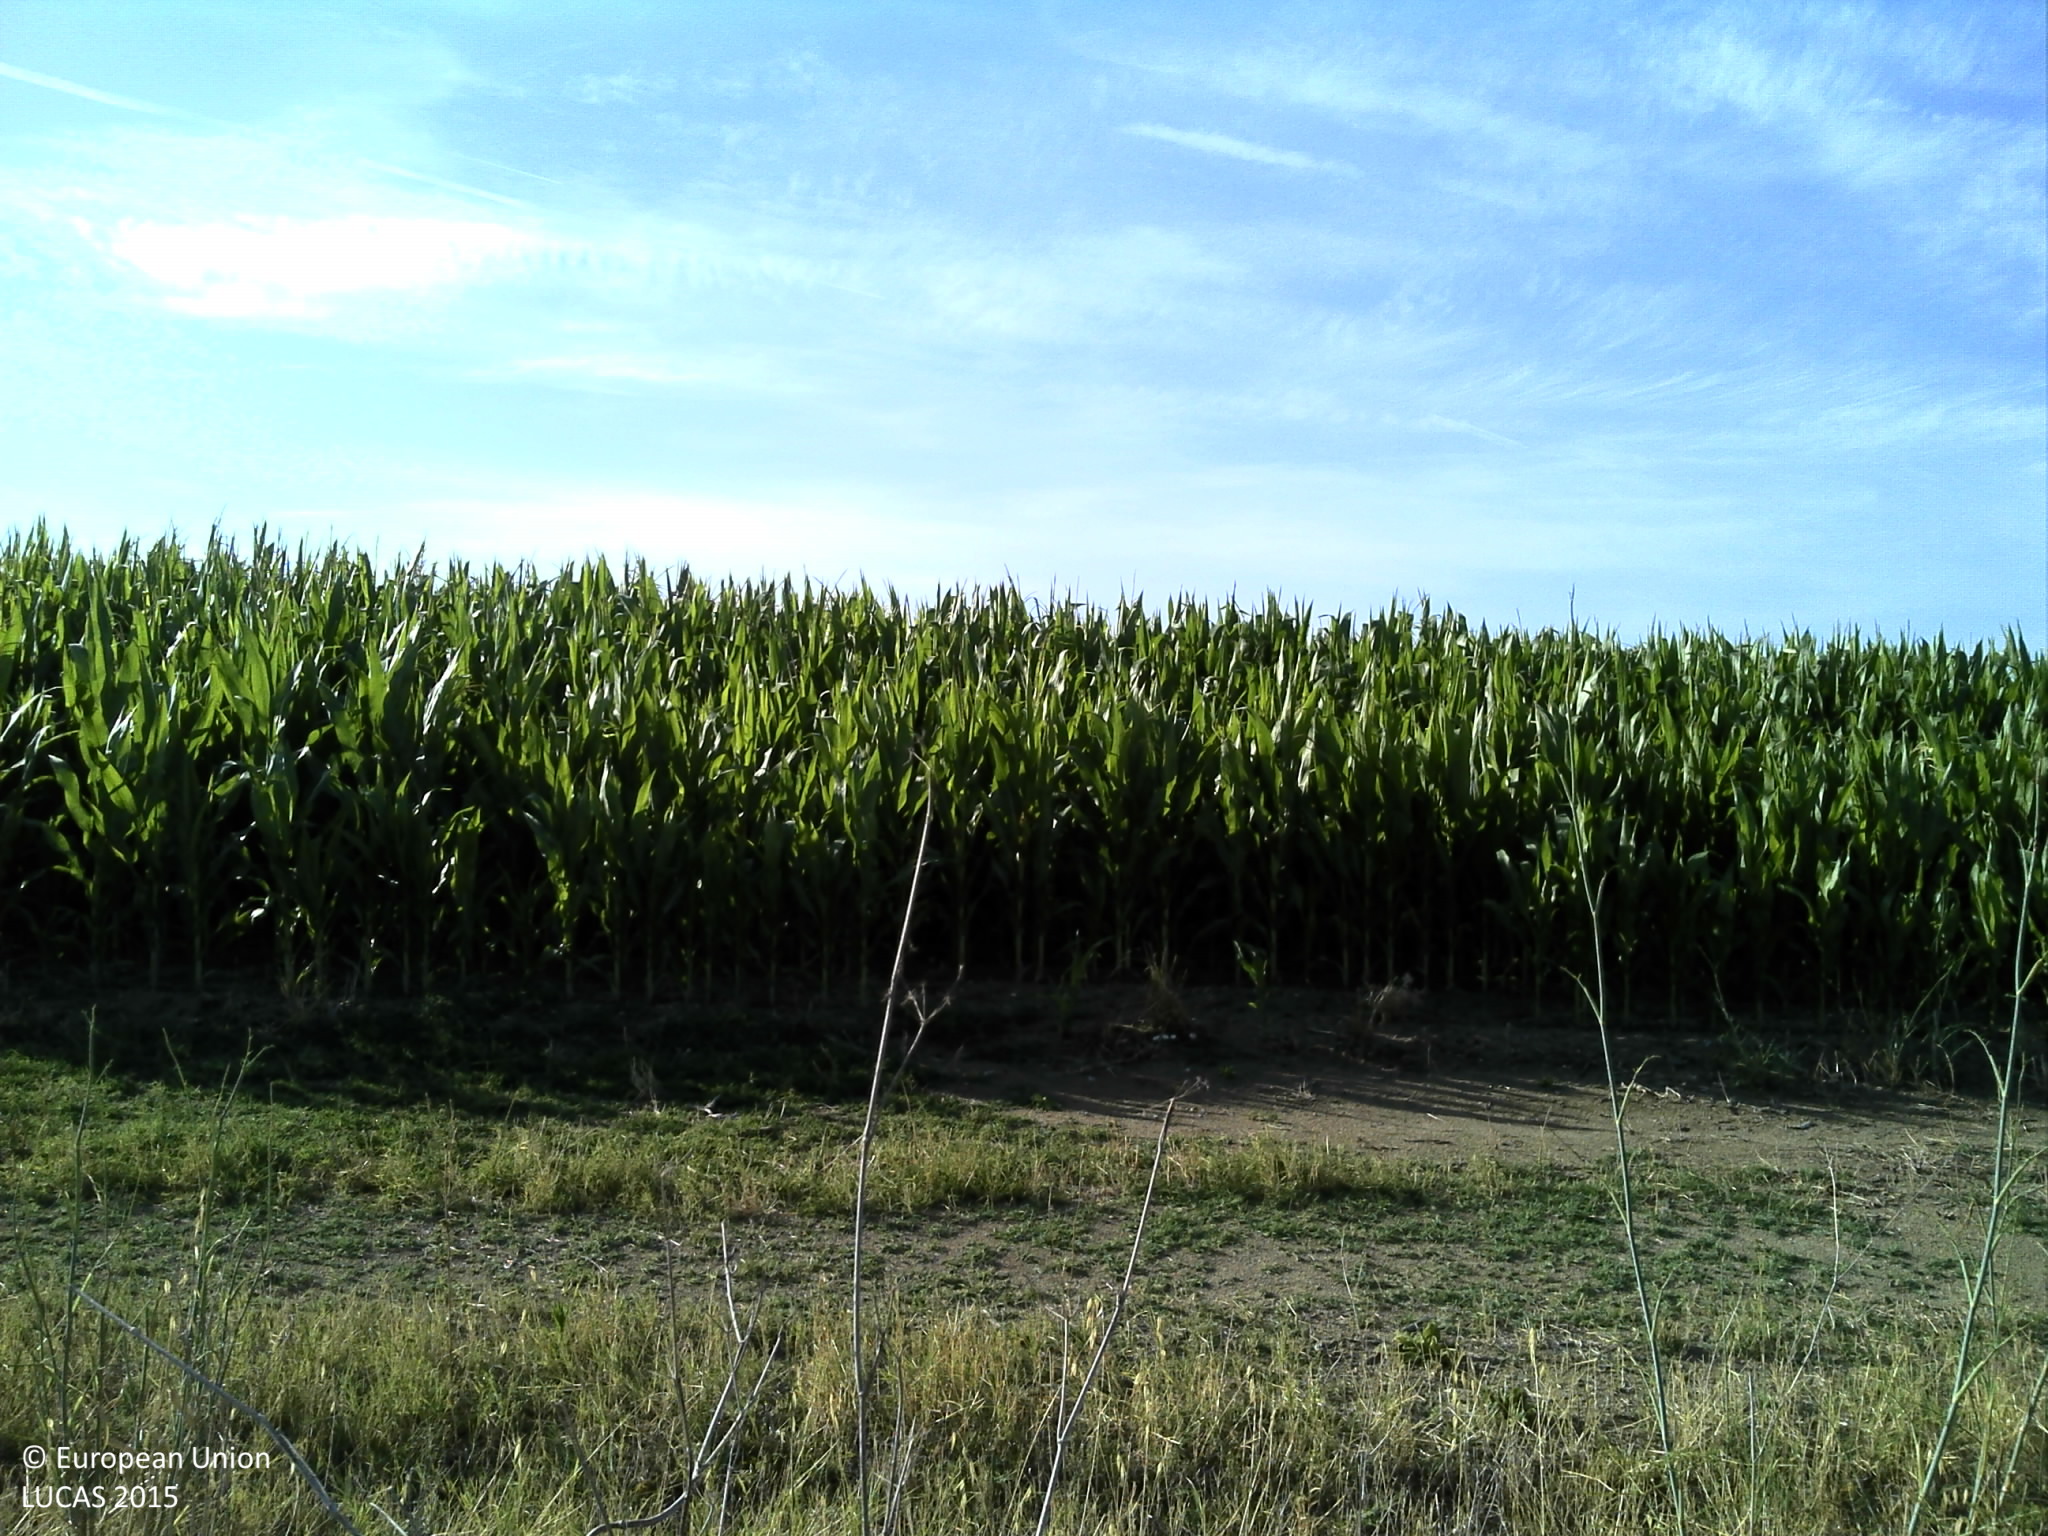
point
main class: Cropland
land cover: Maize
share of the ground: > 75 %
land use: Agriculture (excluding fallow land and kitchen gardens)
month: July
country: PT
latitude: 38.4518
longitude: -7.7369
